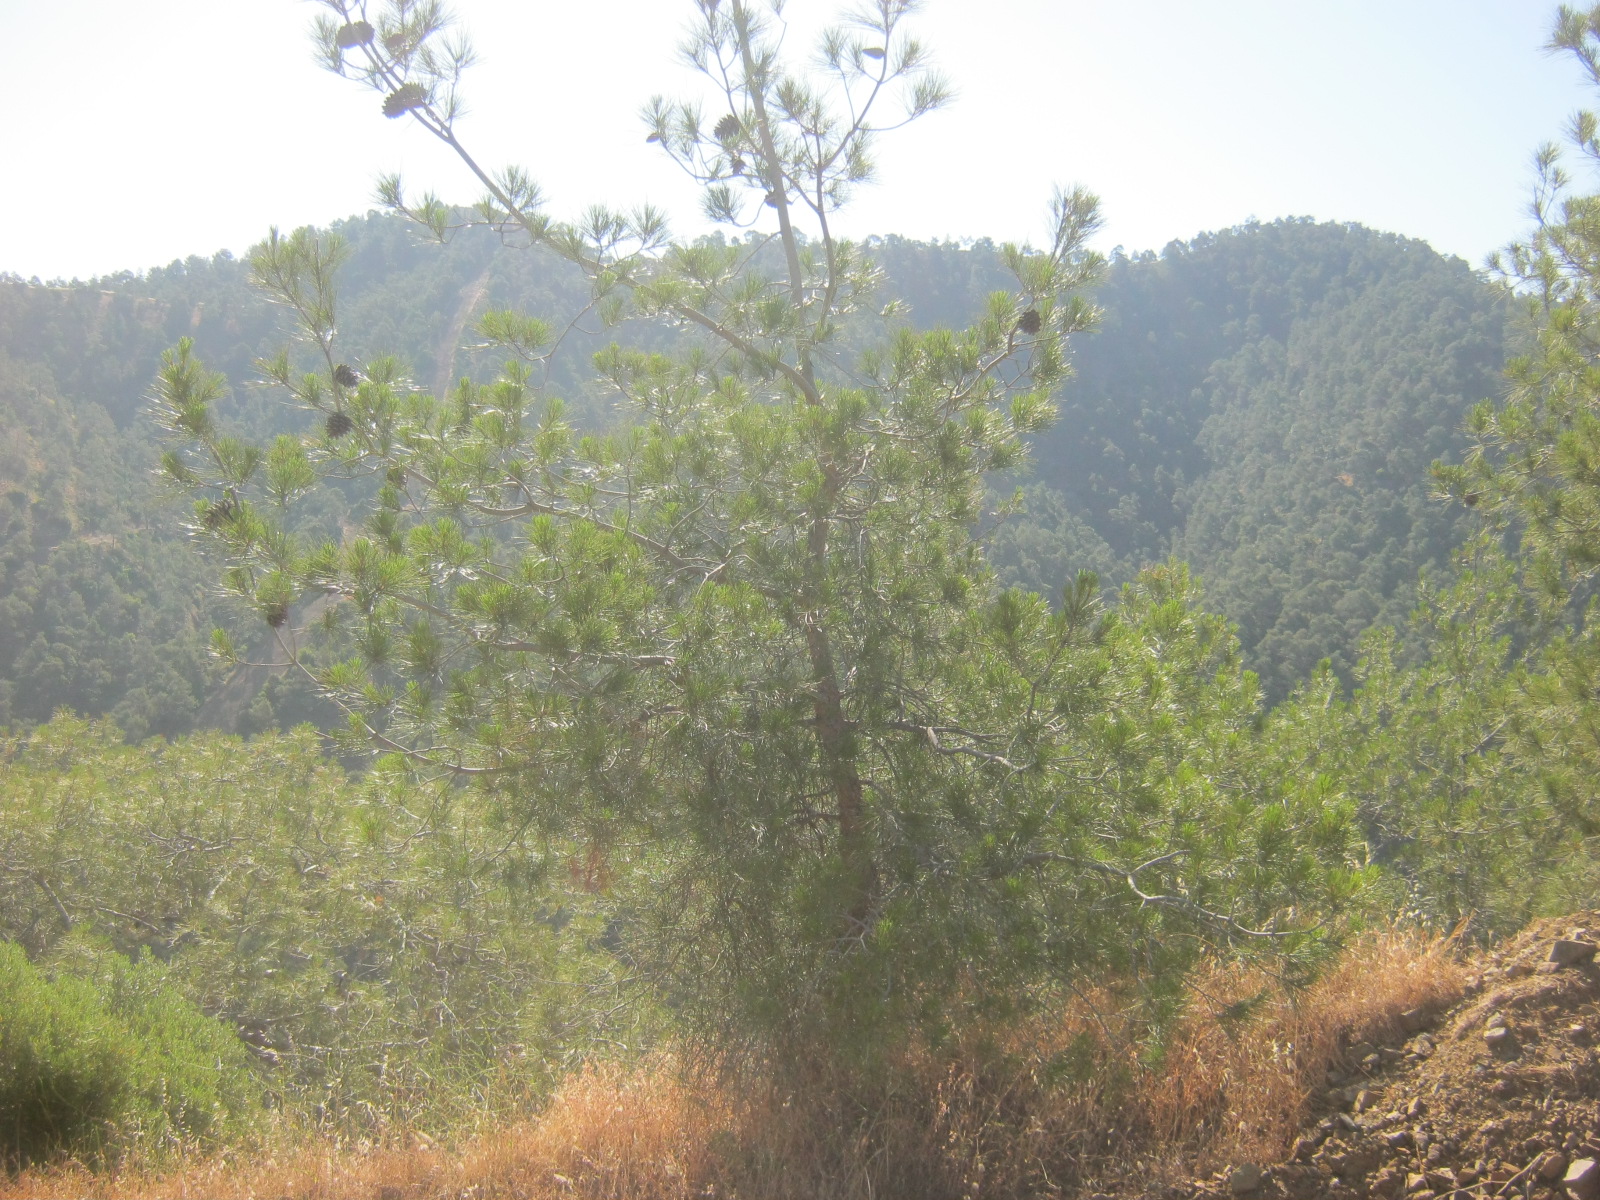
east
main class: Woodland
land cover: Pine dominated coniferous woodland
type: coniferous forest of the mediterranean region
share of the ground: 50 - 75 %
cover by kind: coniferous forest trees 50 %, shrubs 30 %, herbaceous plants 10 %, unconsolidated bare surface 10 %
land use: Forestry
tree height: > 5 m
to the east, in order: Pine dominated coniferous woodland; Shrubland with sparse tree cover; Tracks; Pine dominated coniferous woodland; Tracks
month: May
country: CY
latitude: 35.0439
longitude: 32.8284
